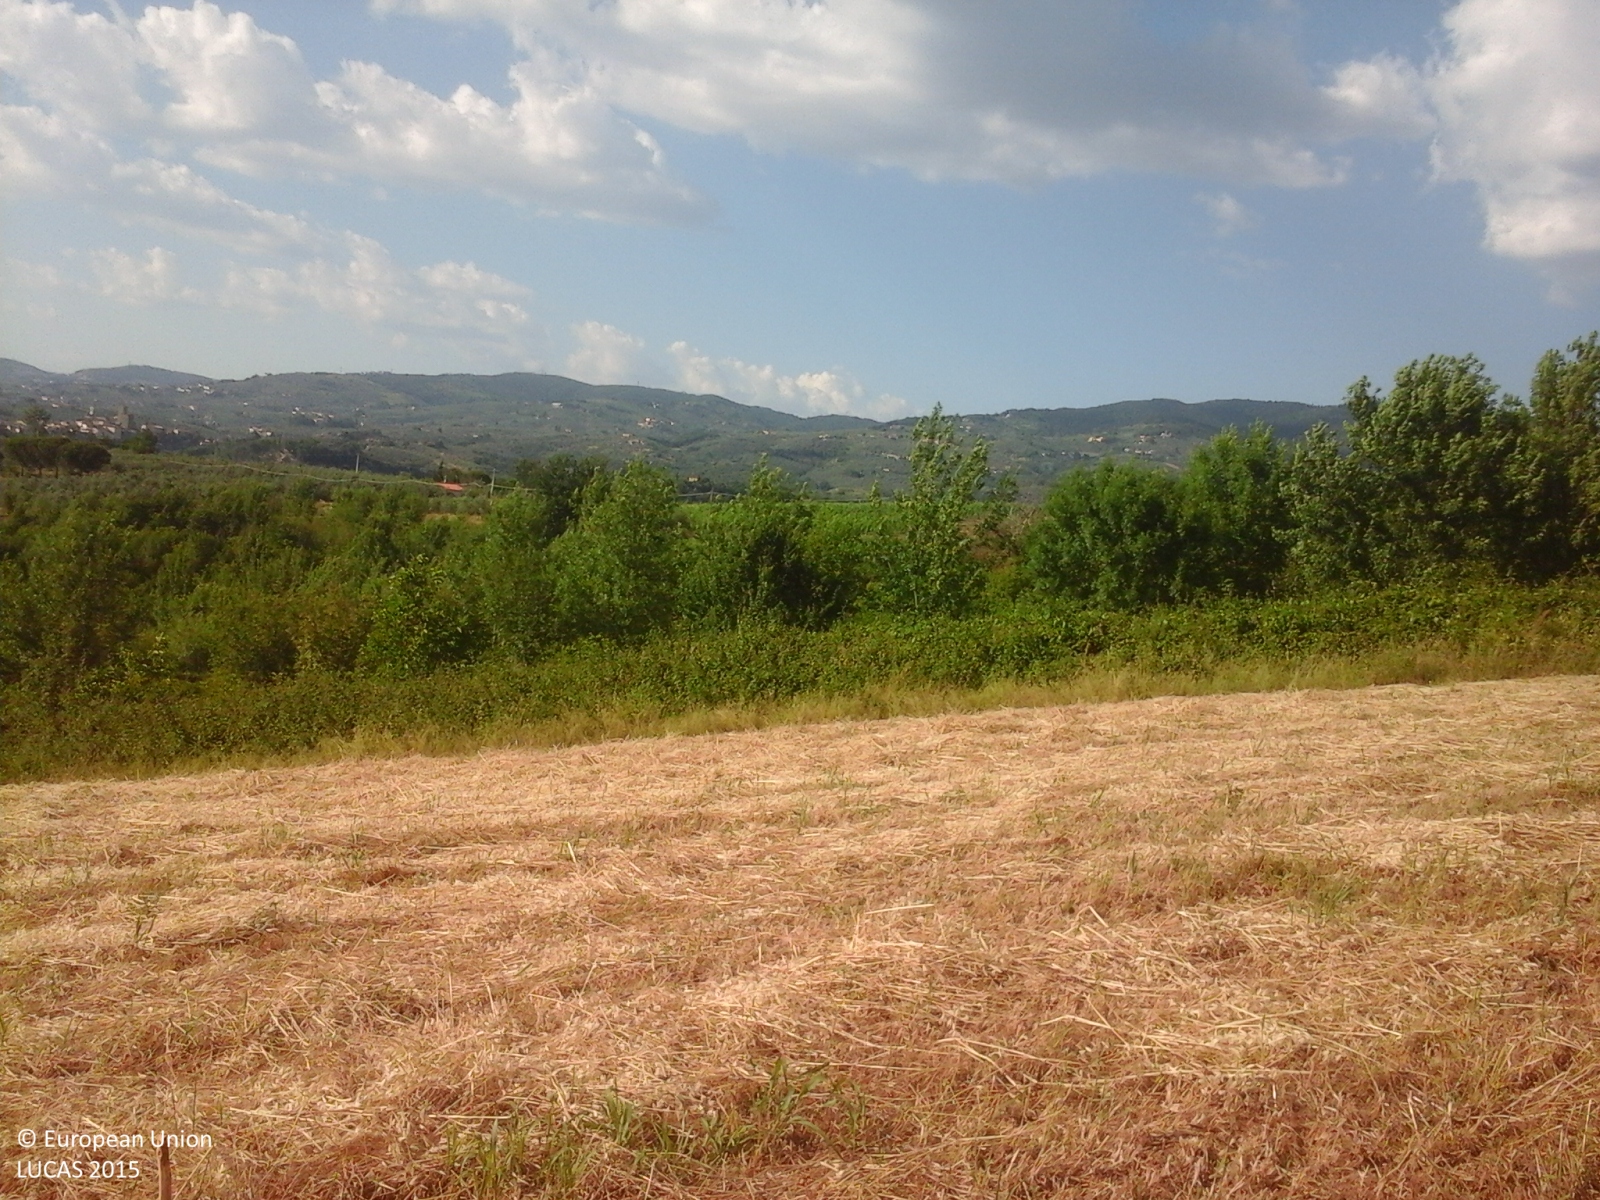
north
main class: Cropland
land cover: Mixed cereals for fodder
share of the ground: > 75 %
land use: Agriculture (excluding fallow land and kitchen gardens)
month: June
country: IT
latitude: 43.7691
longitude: 10.9293
